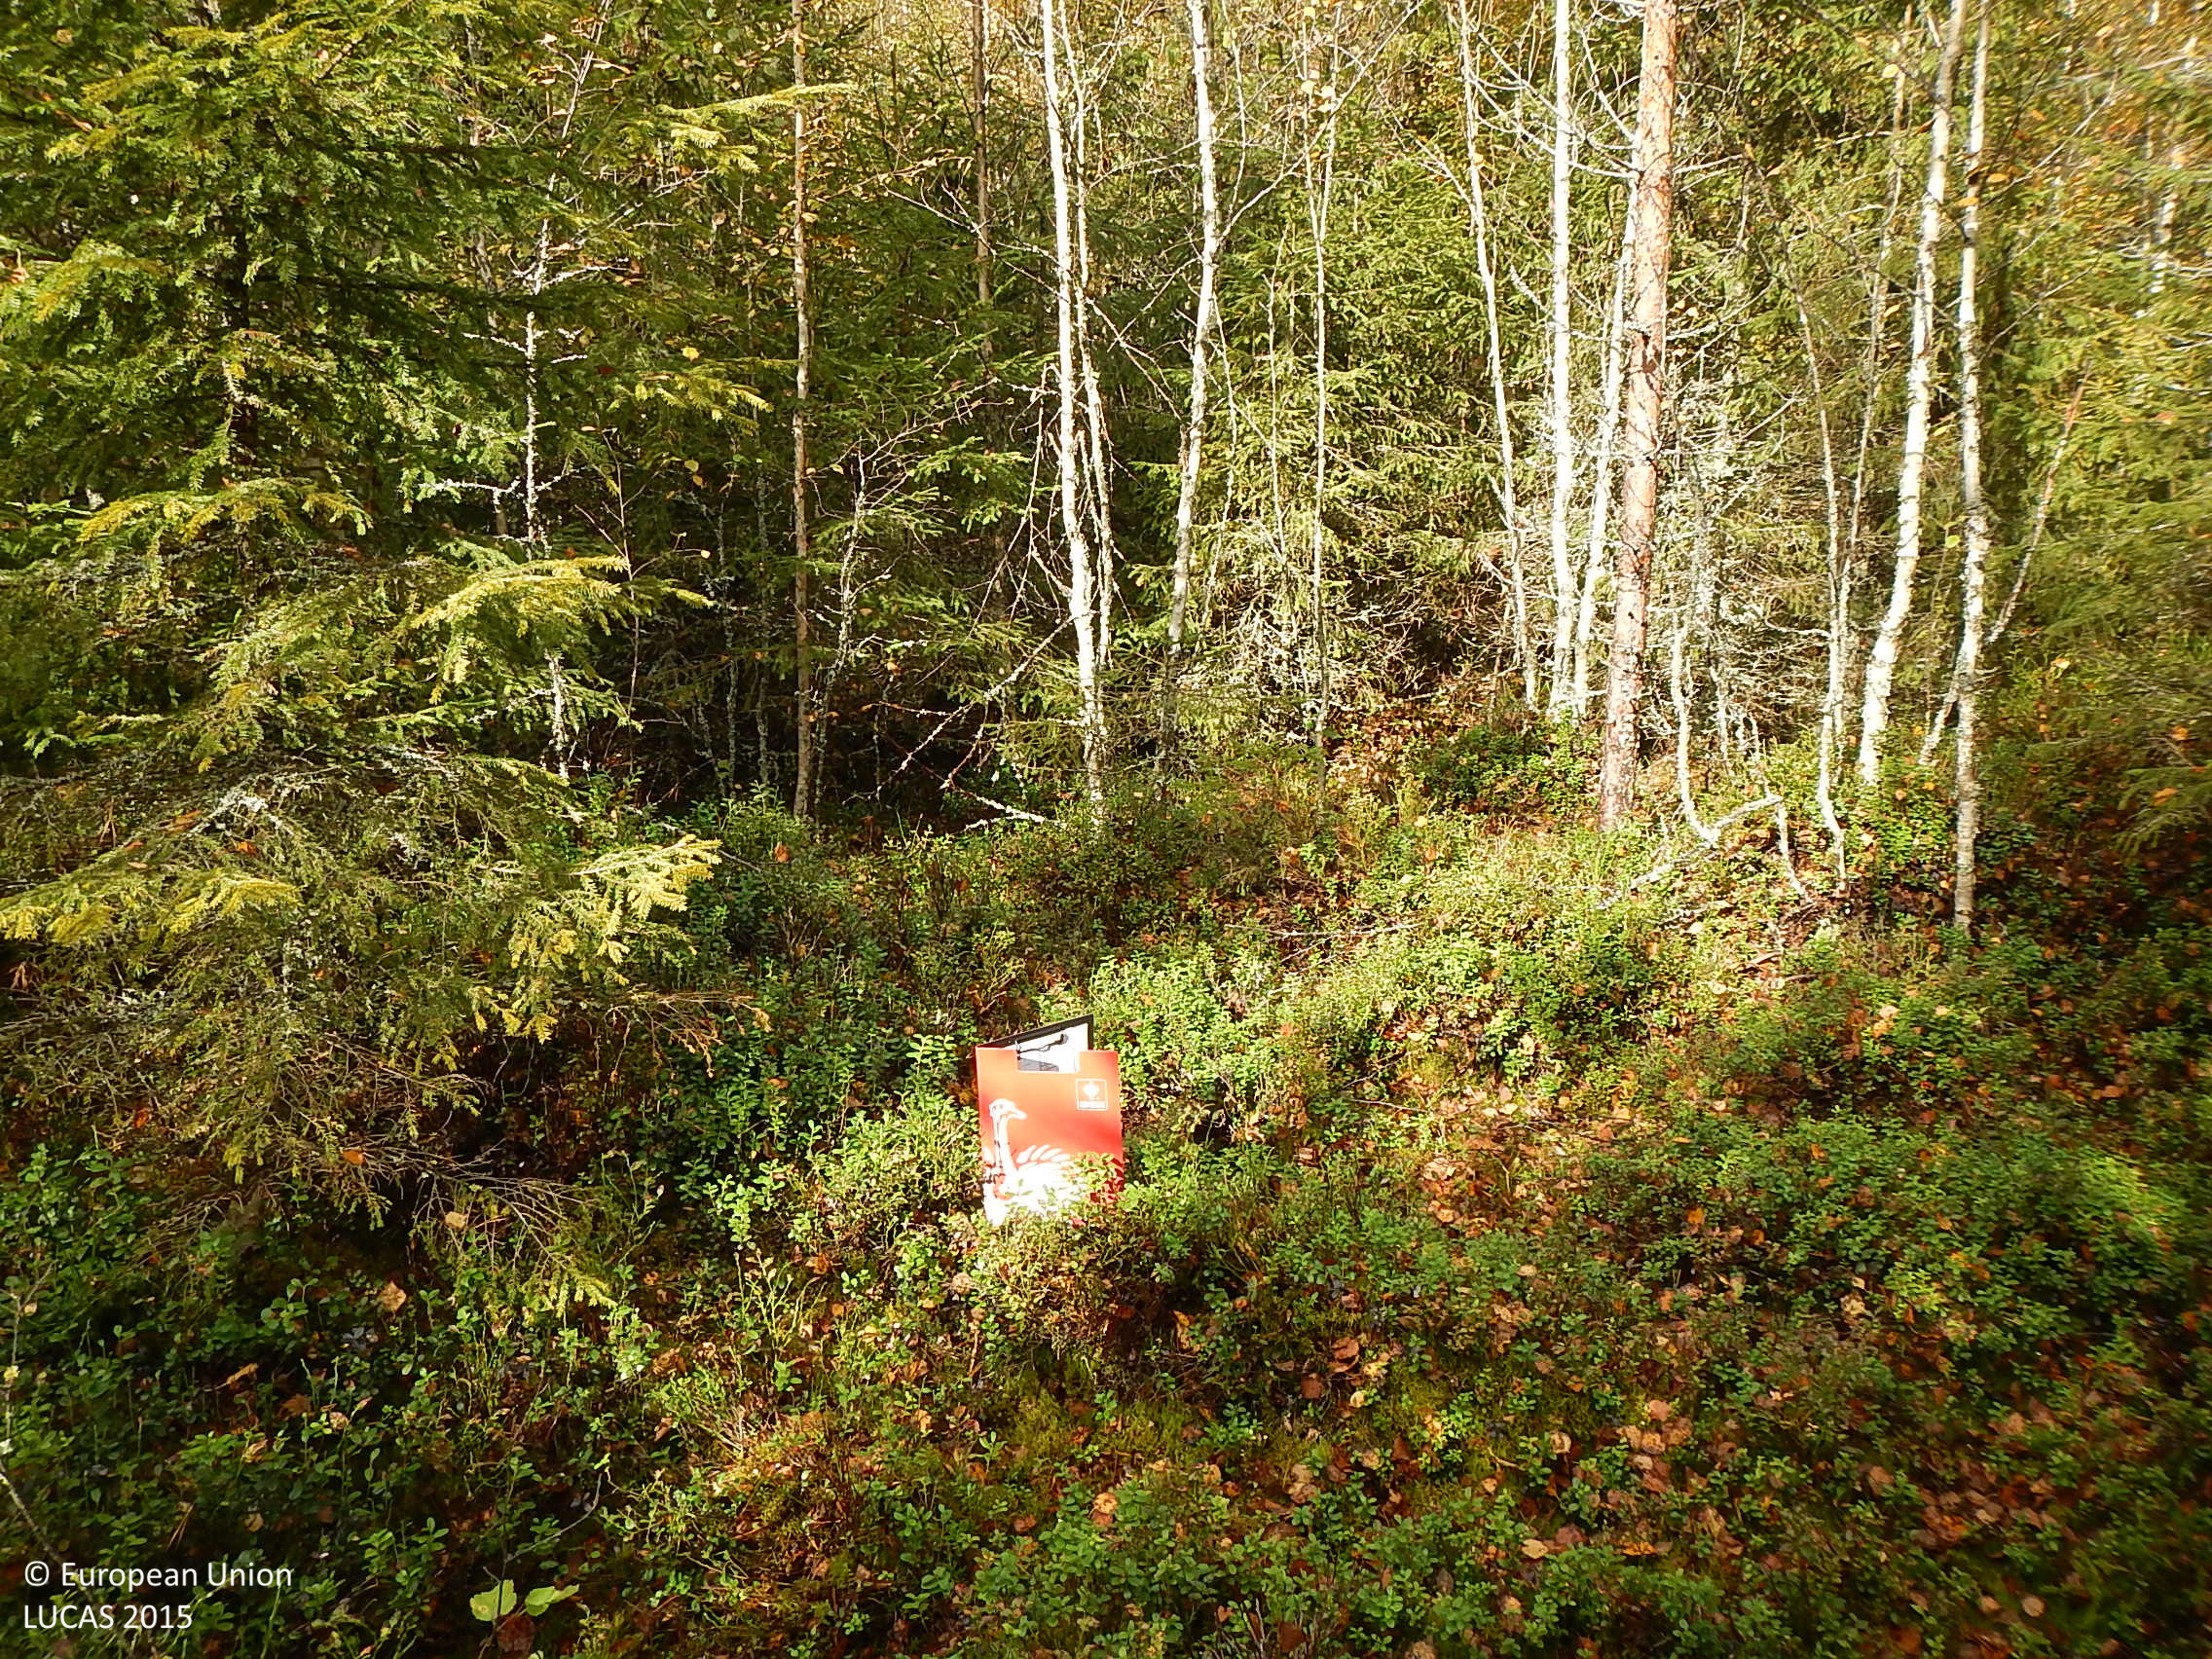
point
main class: Woodland
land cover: Other mixed woodland
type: boreal forest
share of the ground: 50 - 75 %
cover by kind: broadleaved forest trees 40 %, coniferous forest trees 30 %, shrubs 20 %, lichens and mosses 10 %
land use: Forestry
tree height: > 5 m
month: September
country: FI
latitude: 61.8571
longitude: 22.4320
